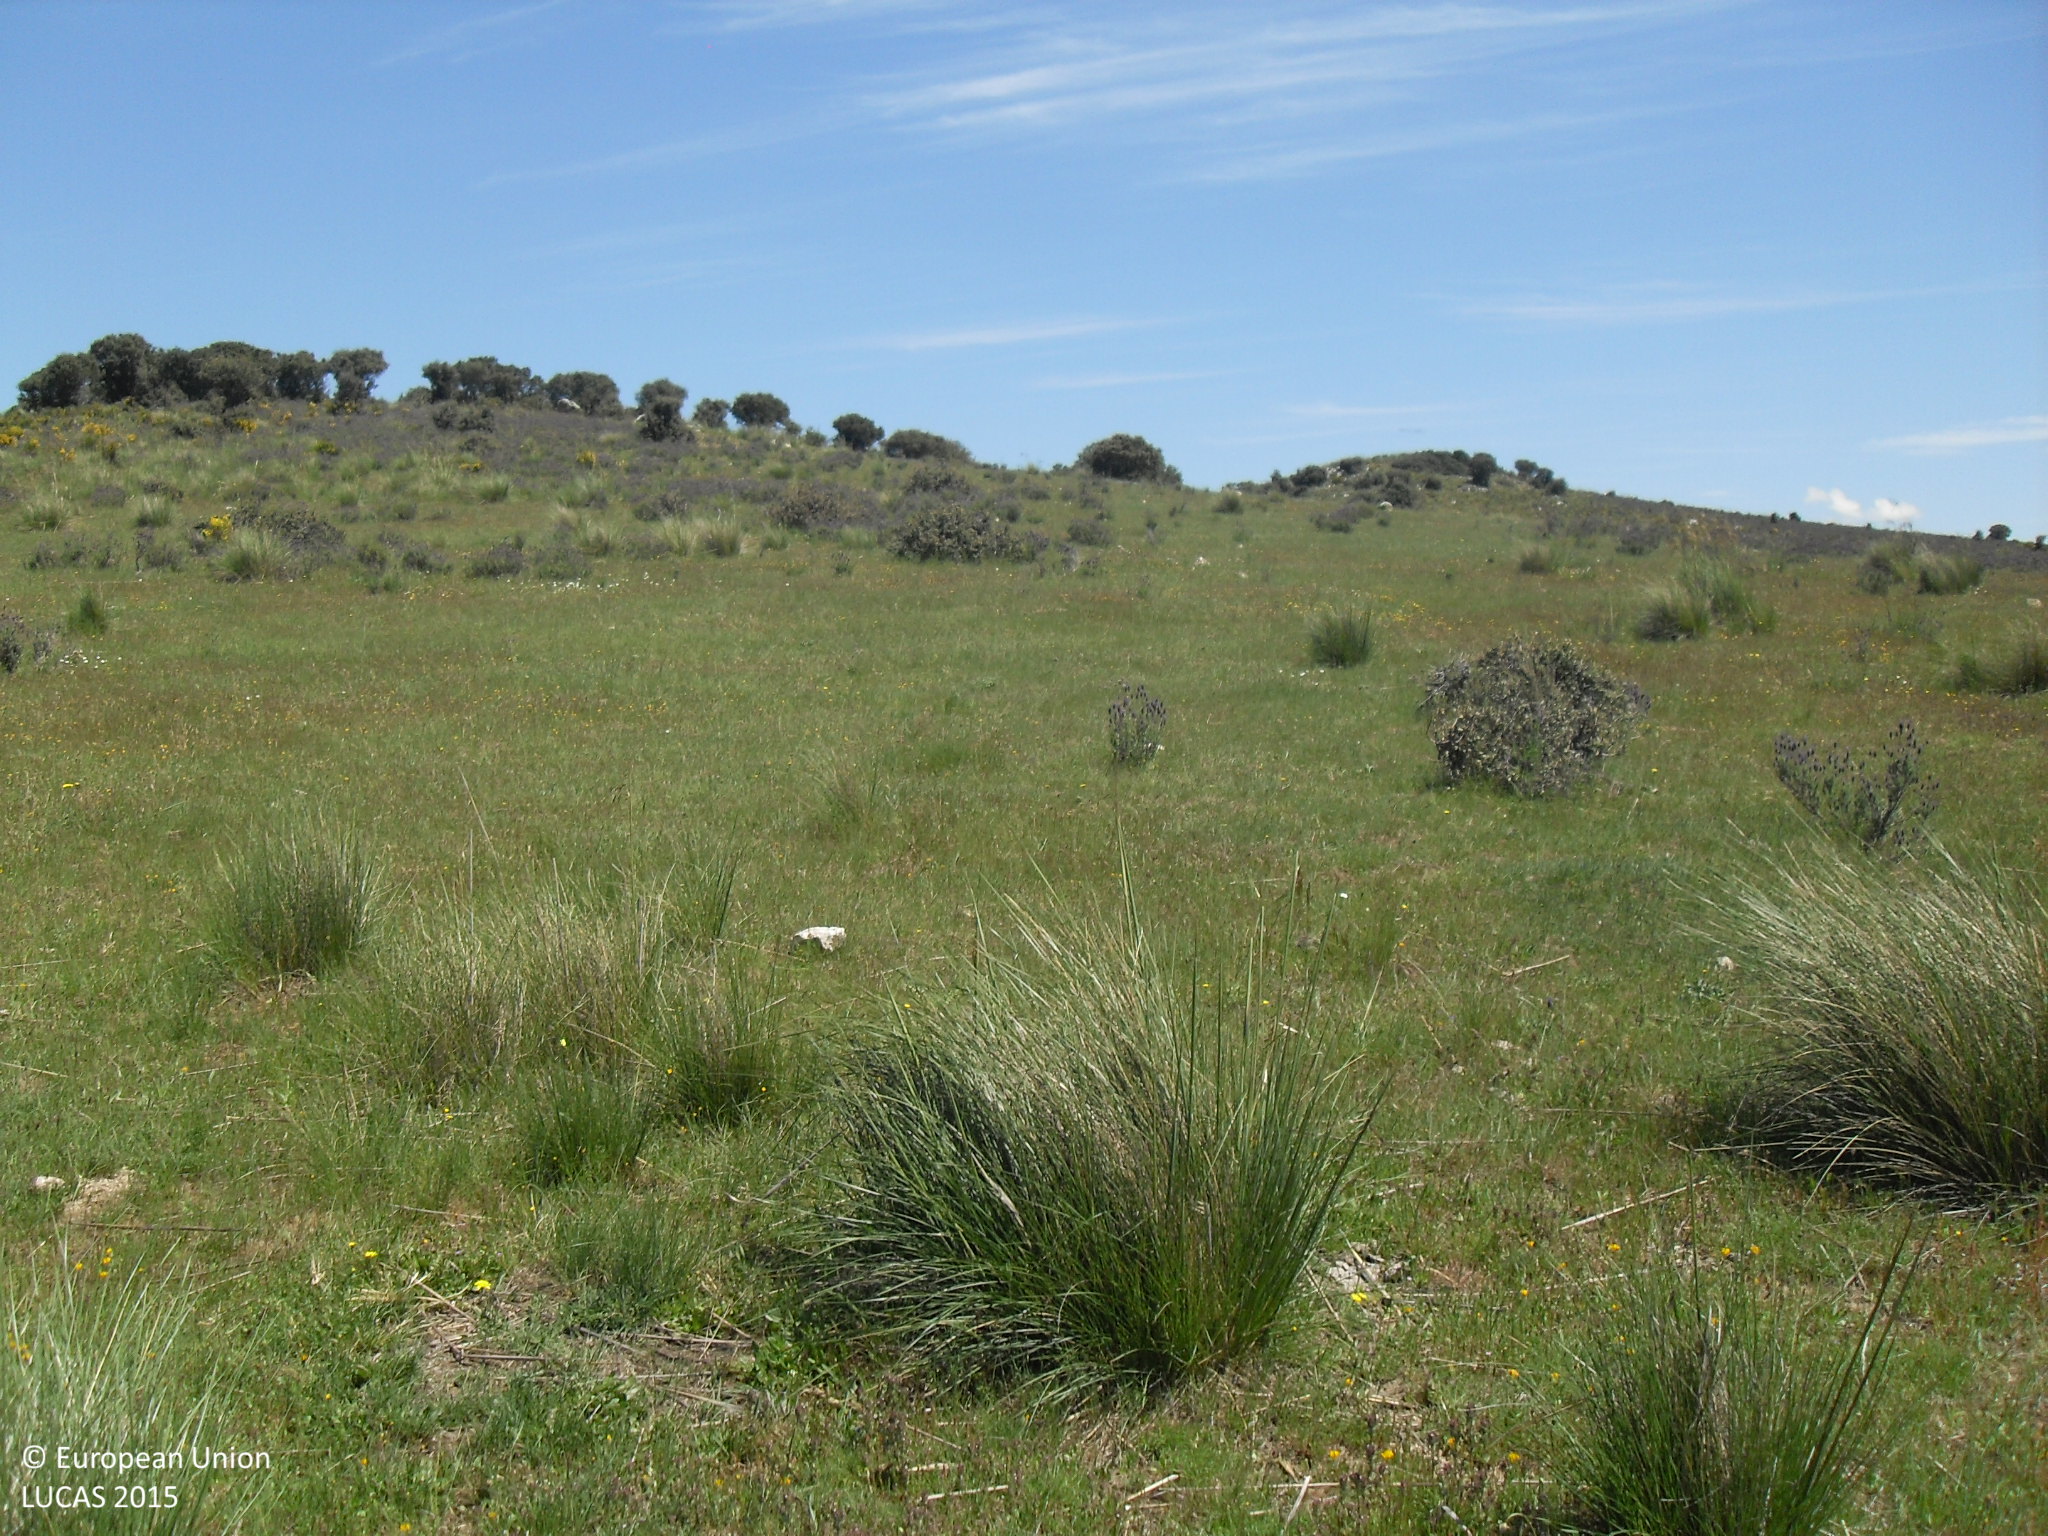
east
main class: Grassland
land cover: Grassland without tree/shrub cover
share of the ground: > 75 %
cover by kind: herbaceous plants 100 %
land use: Agriculture (excluding fallow land and kitchen gardens)
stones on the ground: < 10 %
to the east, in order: Grassland without tree/shrub cover; Tracks; Grassland with sparse tree/shrub cover; Grassland without tree/shrub cover
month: May
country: ES
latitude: 40.7342
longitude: -5.1619
